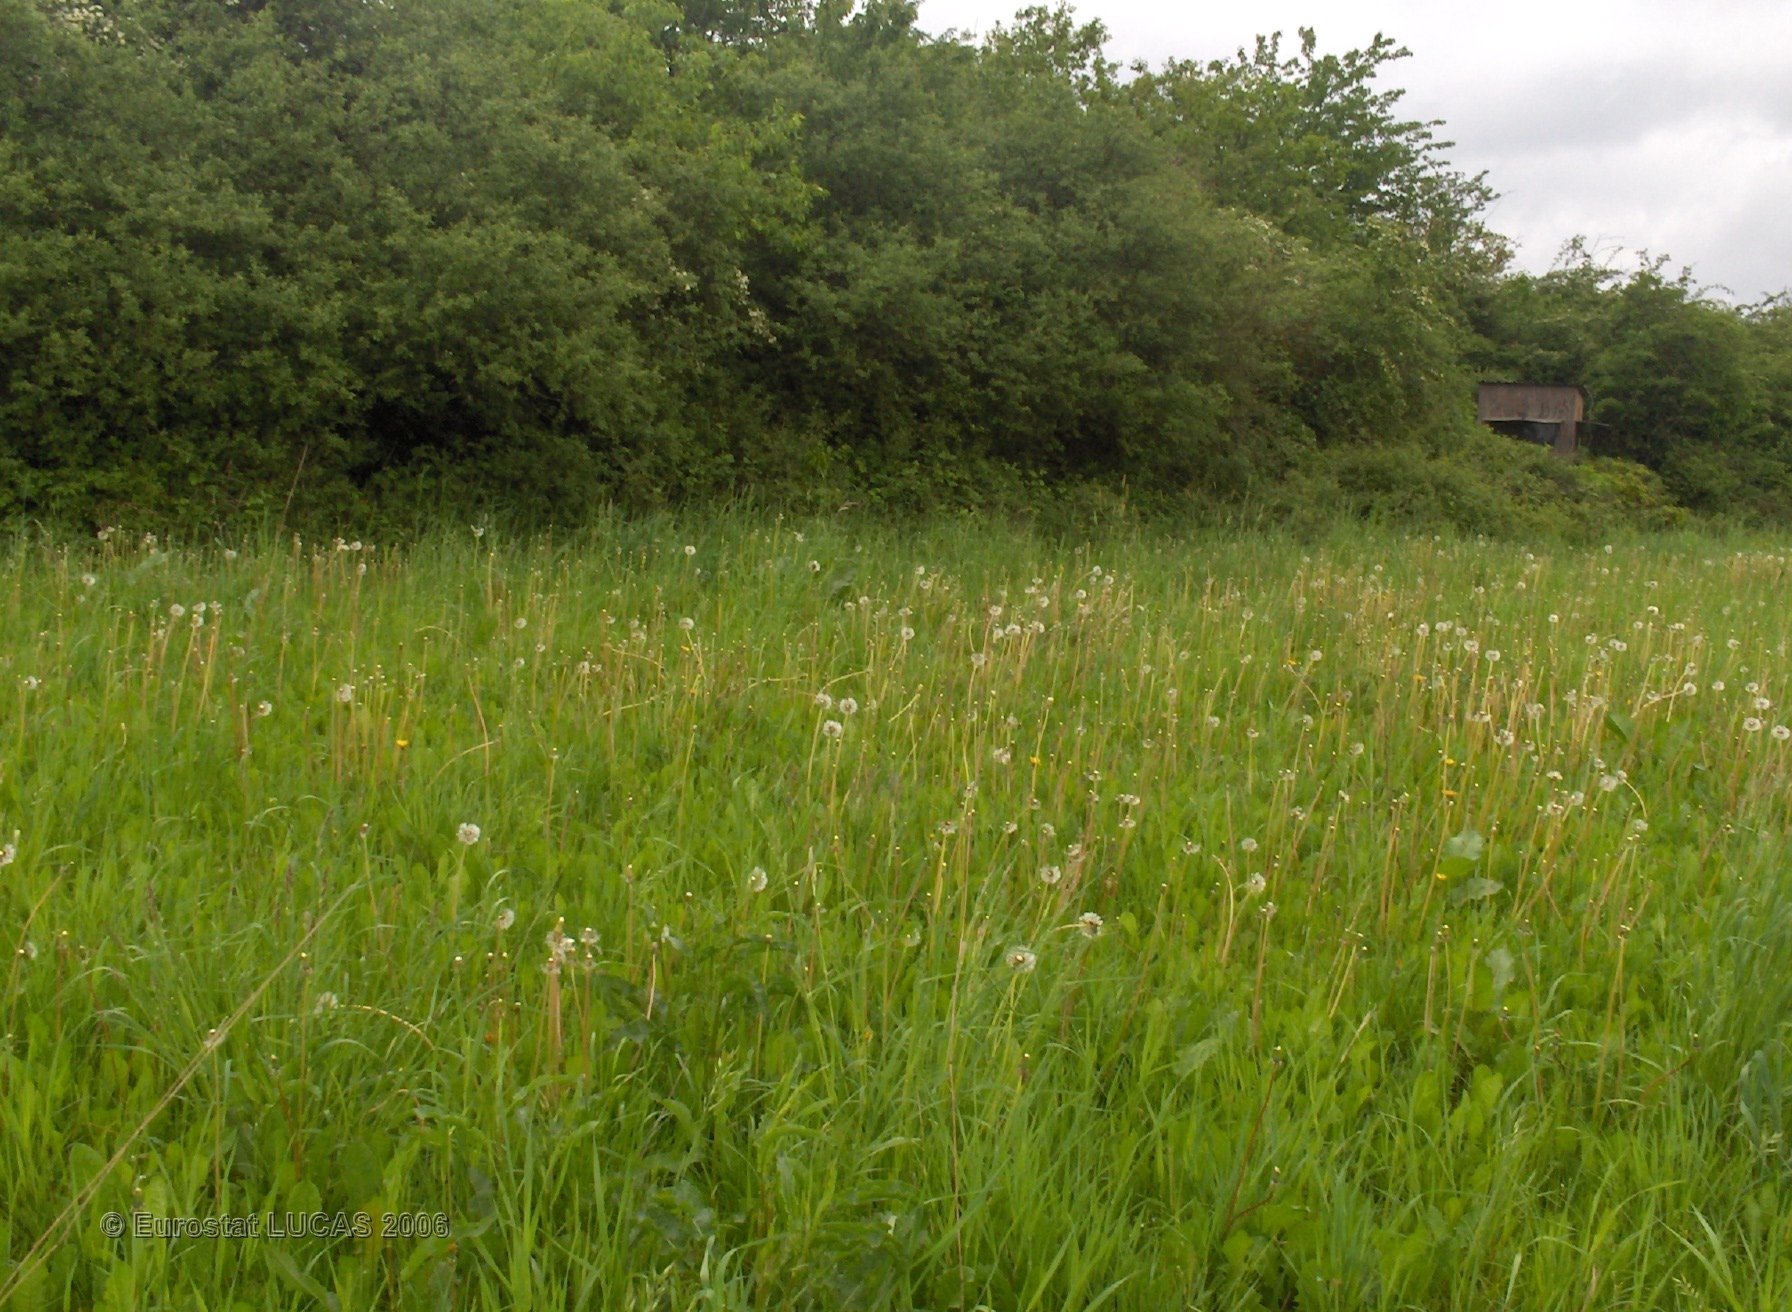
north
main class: Grassland
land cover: Grassland without tree/shrub cover
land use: Agriculture (excluding fallow land and kitchen gardens)
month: May
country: BE
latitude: 50.2663
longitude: 5.2700
